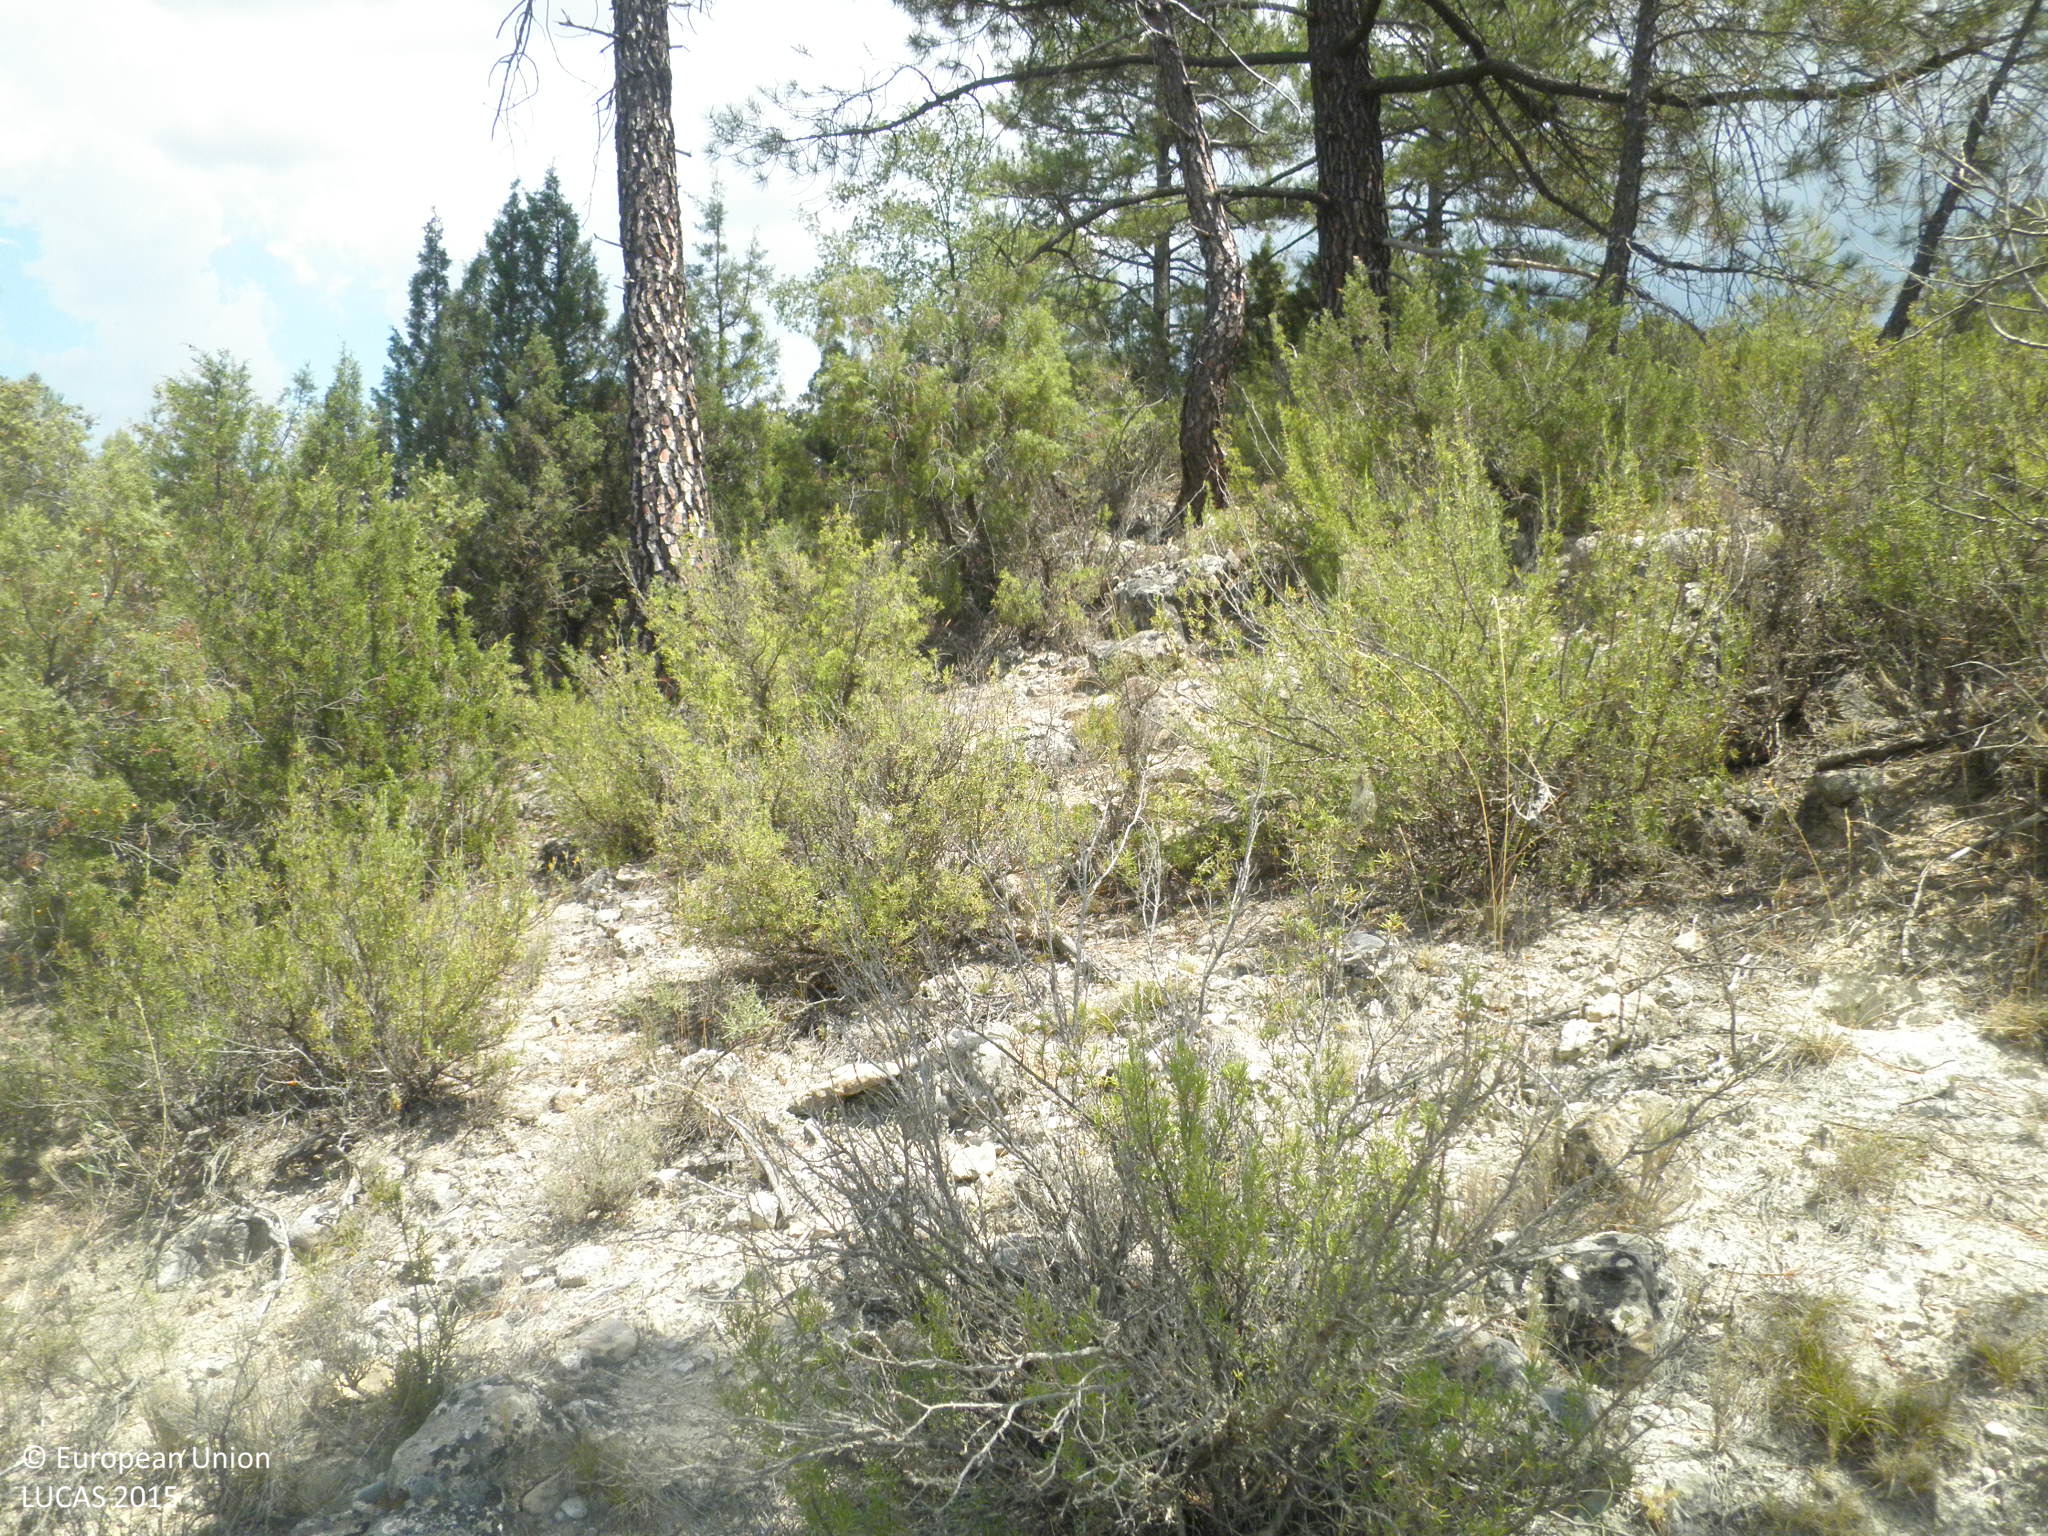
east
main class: Woodland
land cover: Pine dominated coniferous woodland
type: coniferous forest of the mediterranean region
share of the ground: 10 - 25 %
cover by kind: unconsolidated bare surface 50 %, shrubs 40 %, coniferous forest trees 10 %
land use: Semi-natural and natural areas not in use
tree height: > 5 m
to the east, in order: Pine dominated coniferous woodland; Shrubland with sparse tree cover
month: July
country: ES
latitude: 39.7346
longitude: -1.8056
